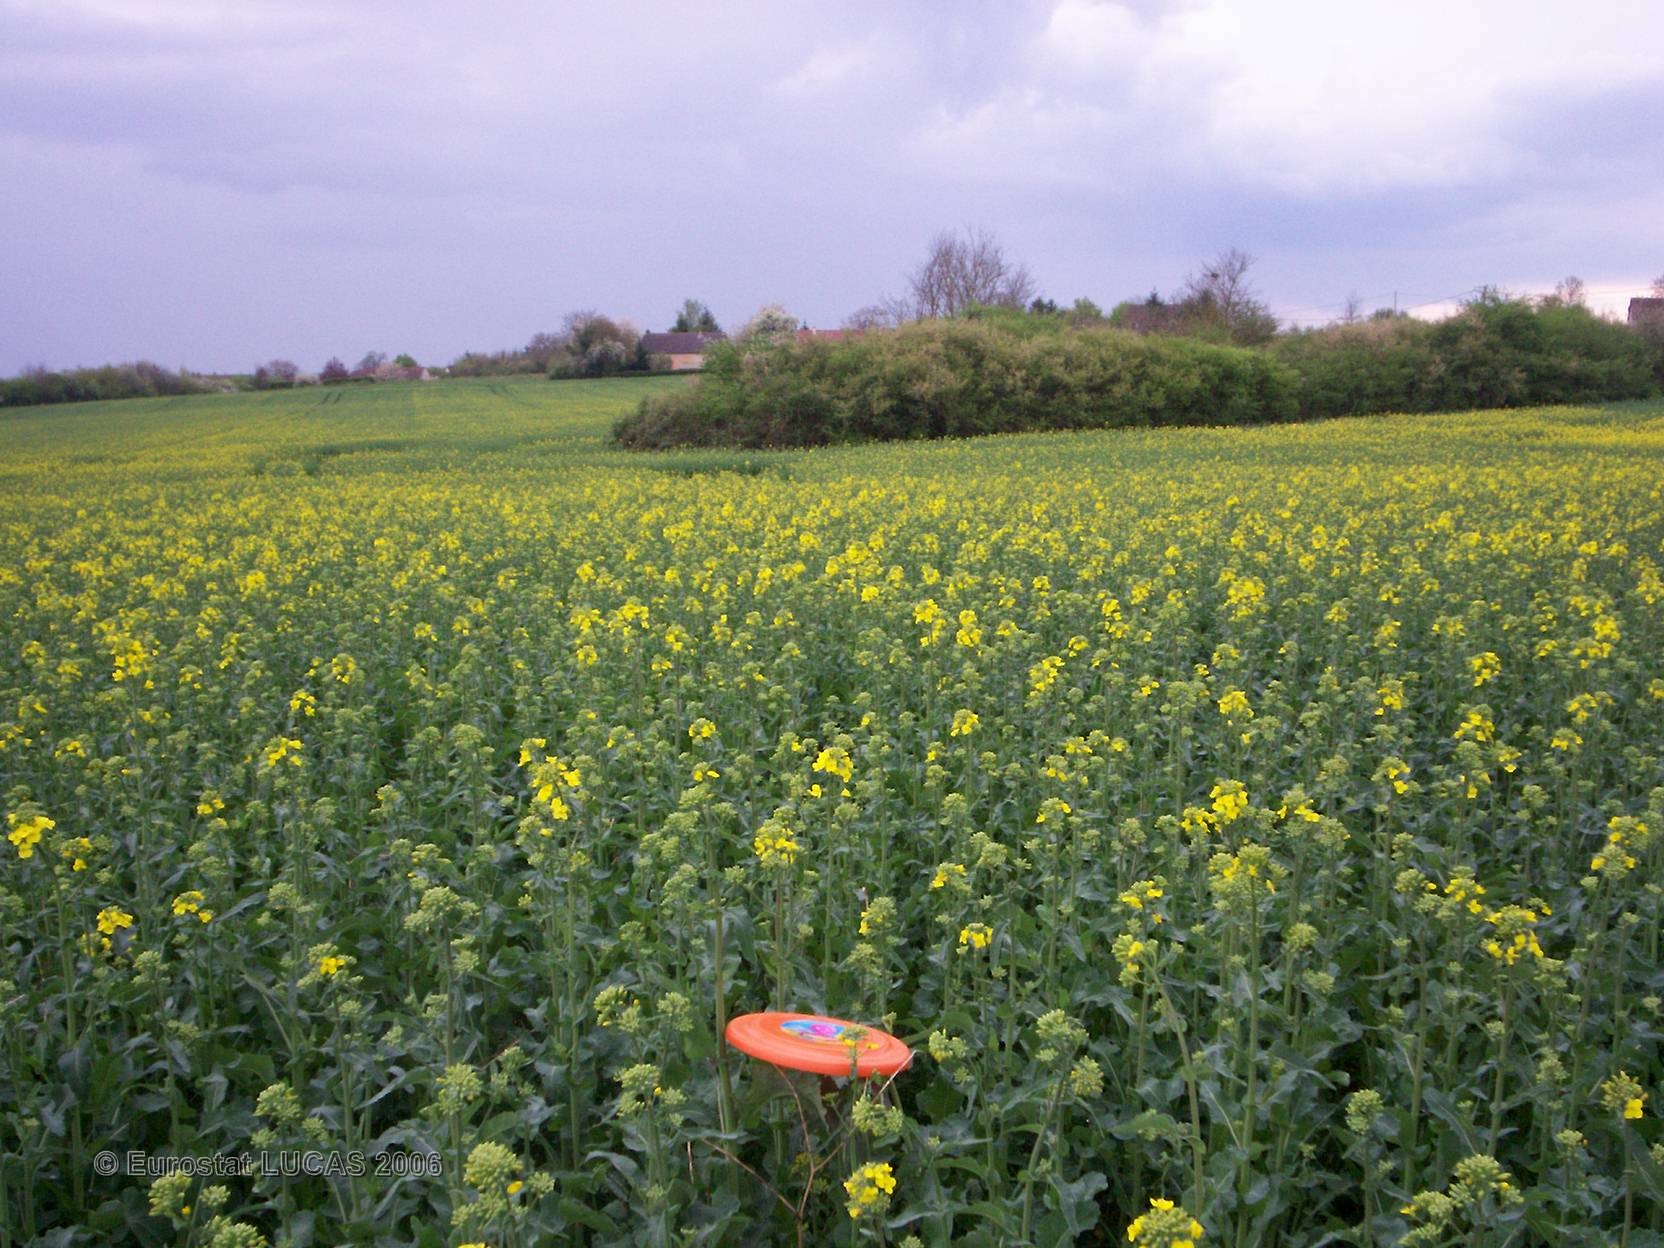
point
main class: Cropland
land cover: Rape and turnip rape
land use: Agriculture (excluding fallow land and kitchen gardens)
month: April
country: FR
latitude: 47.2947
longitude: 2.9728
